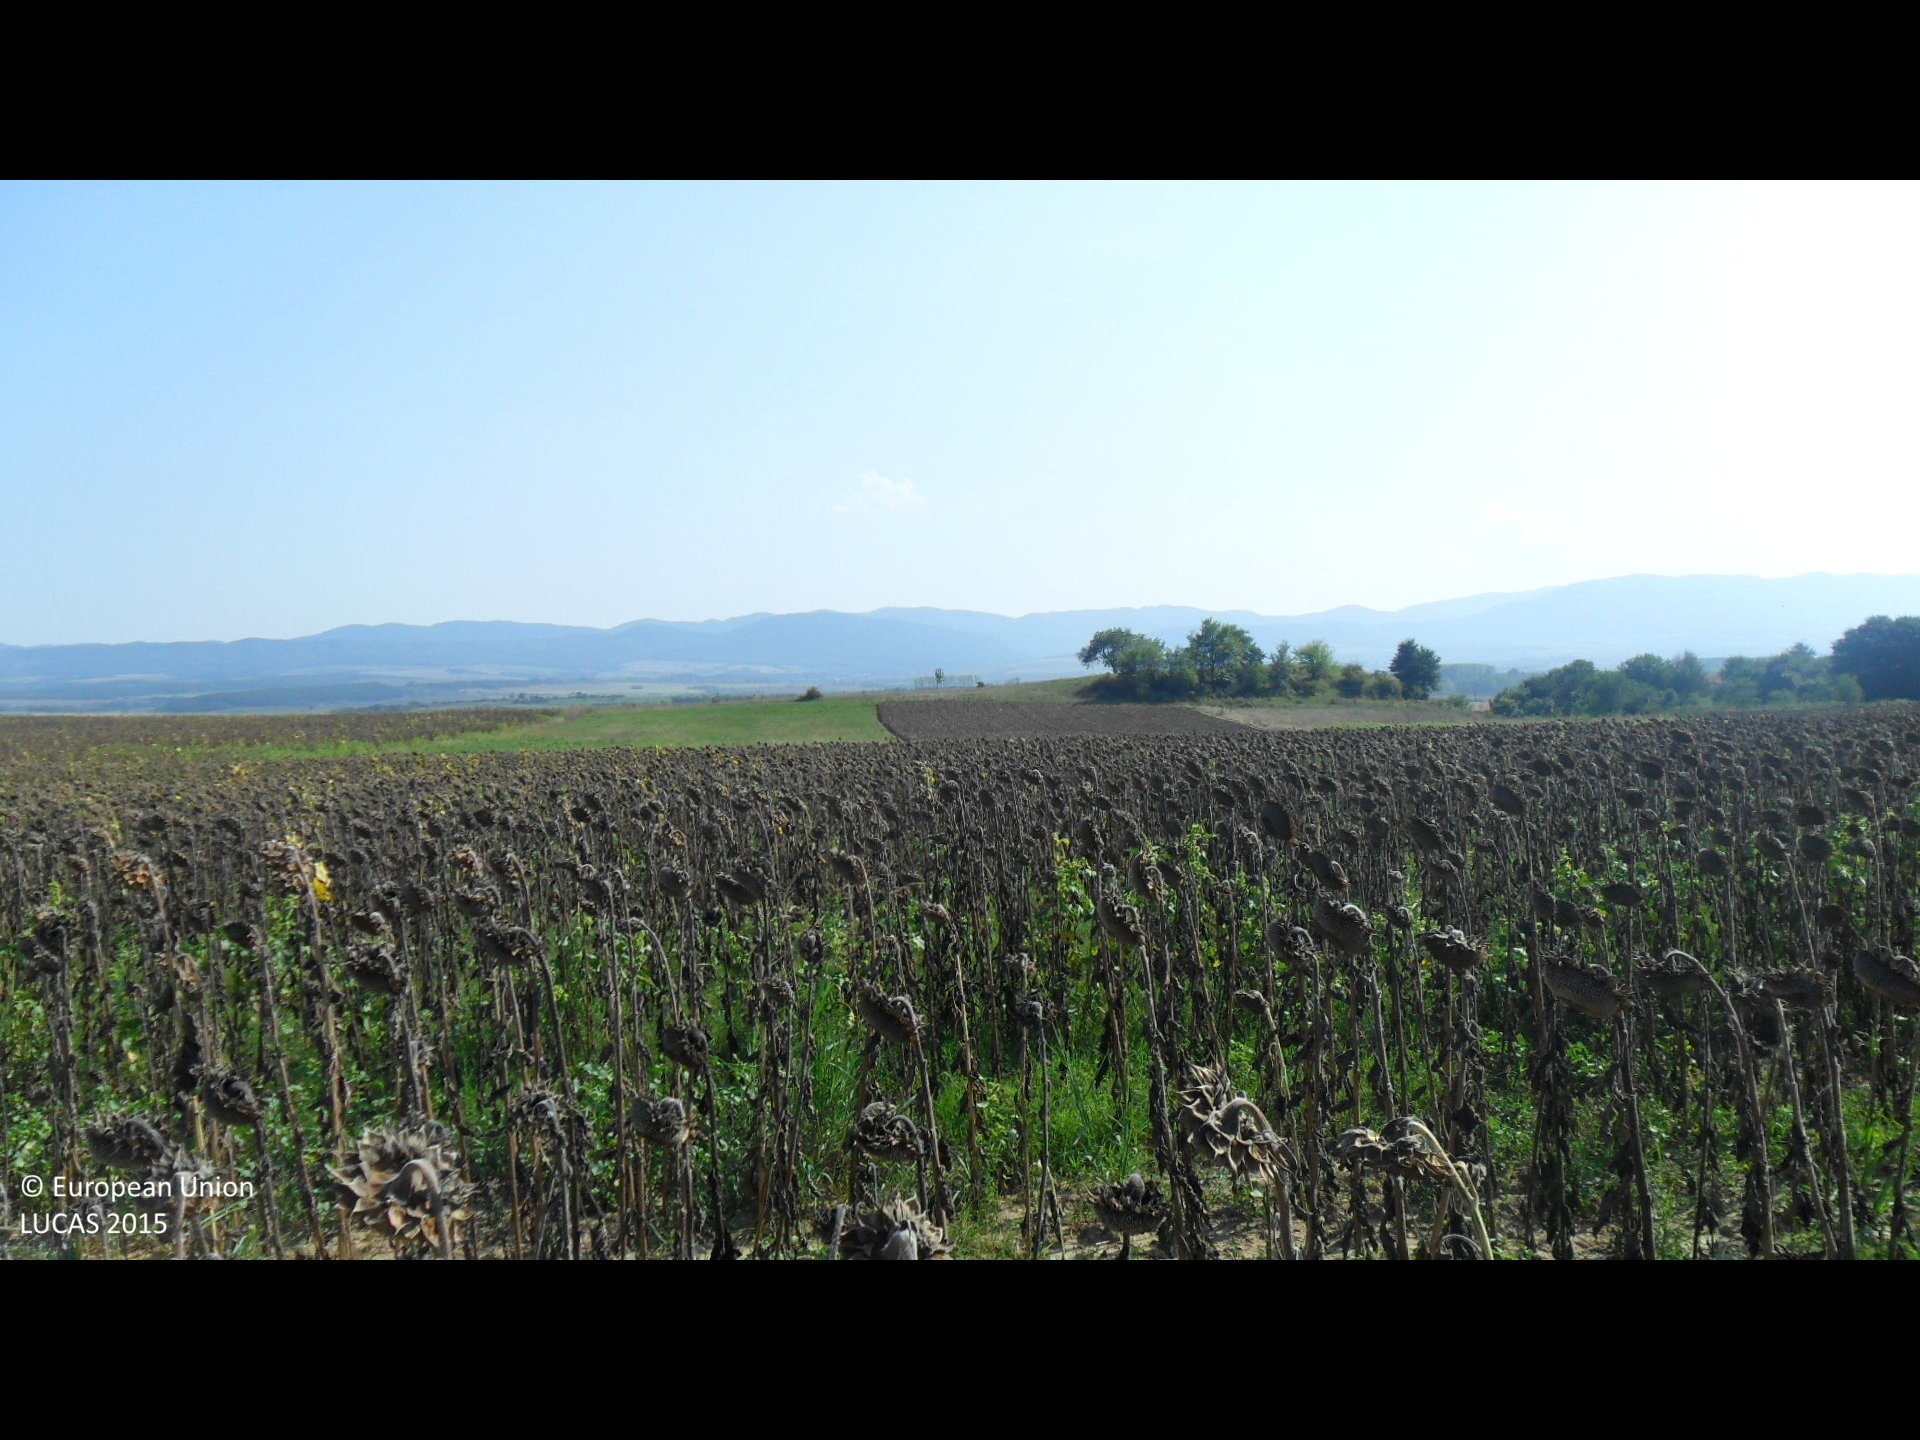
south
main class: Cropland
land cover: Sunflower
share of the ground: > 75 %
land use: Agriculture (excluding fallow land and kitchen gardens)
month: September
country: BG
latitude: 43.0643
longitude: 26.6687
